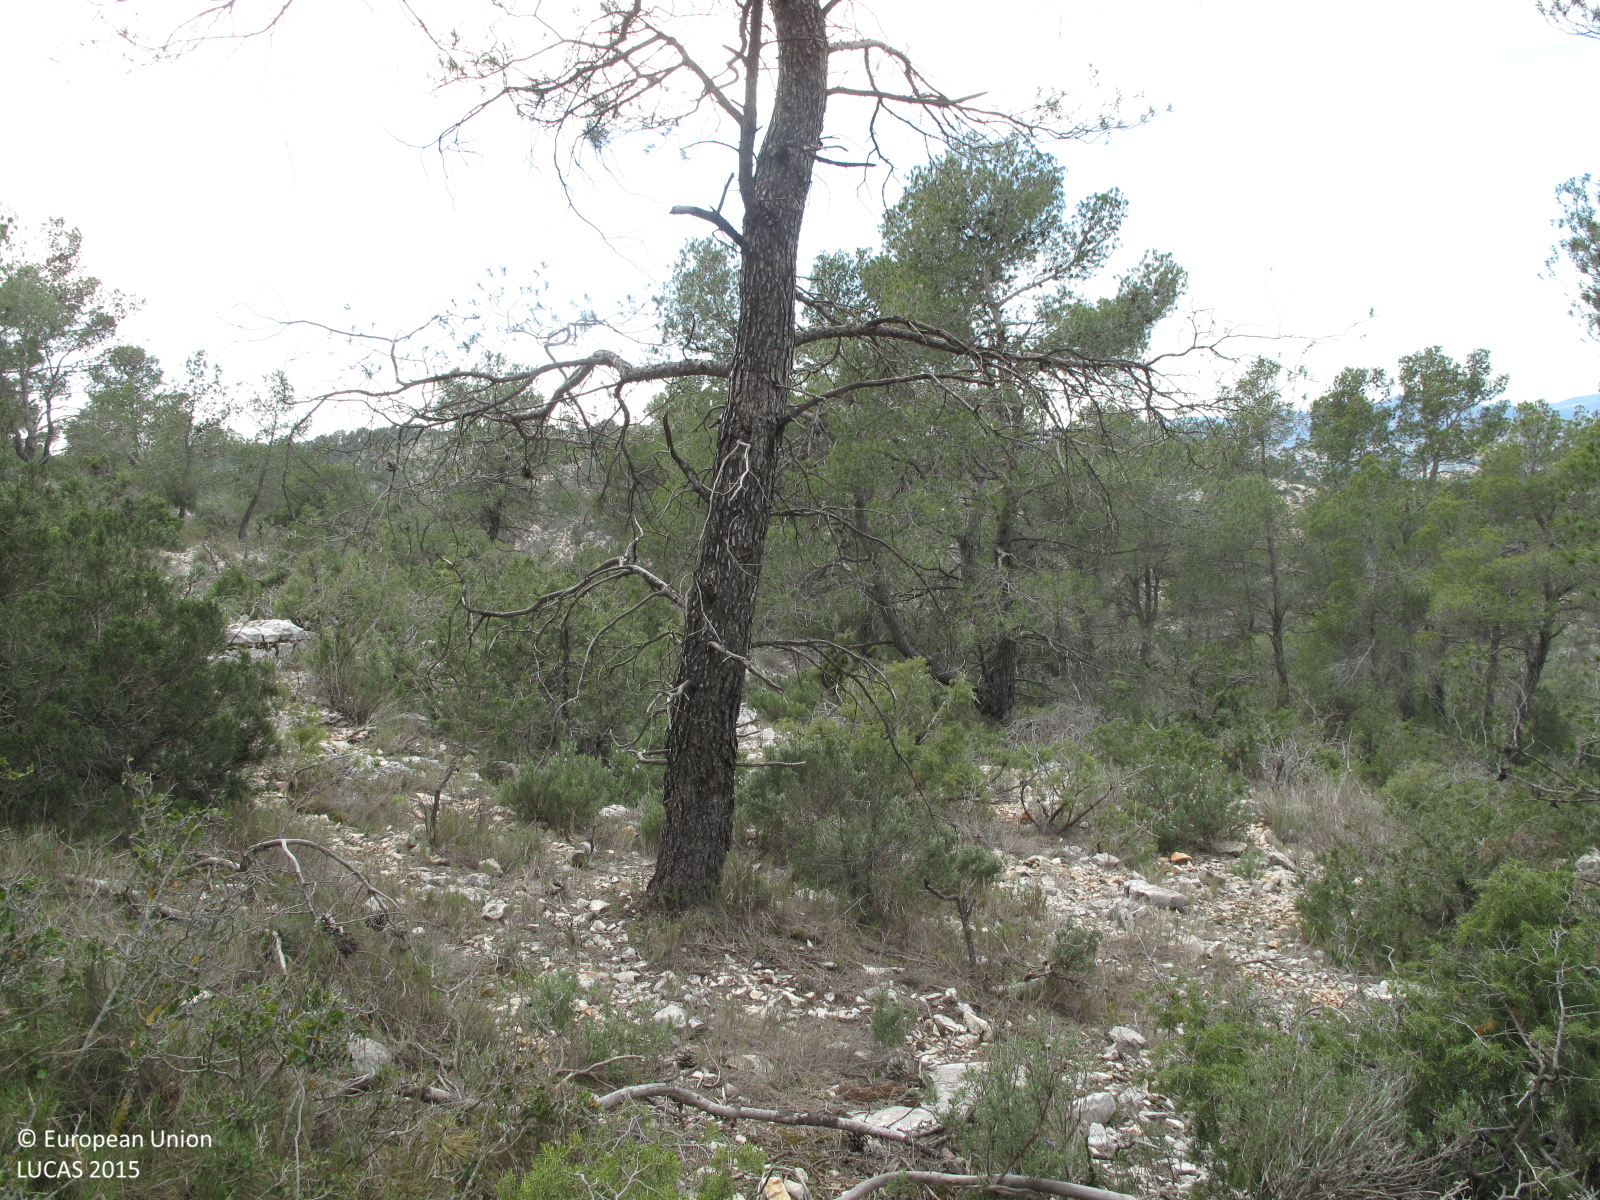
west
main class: Woodland
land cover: Pine dominated coniferous woodland
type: coniferous forest of the mediterranean region
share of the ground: 50 - 75 %
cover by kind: coniferous forest trees 60 %, consolidated bare surface 20 %, shrubs 10 %, herbaceous plants 10 %
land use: Semi-natural and natural areas not in use
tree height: > 5 m
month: March
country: ES
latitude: 38.7597
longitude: -0.7742
